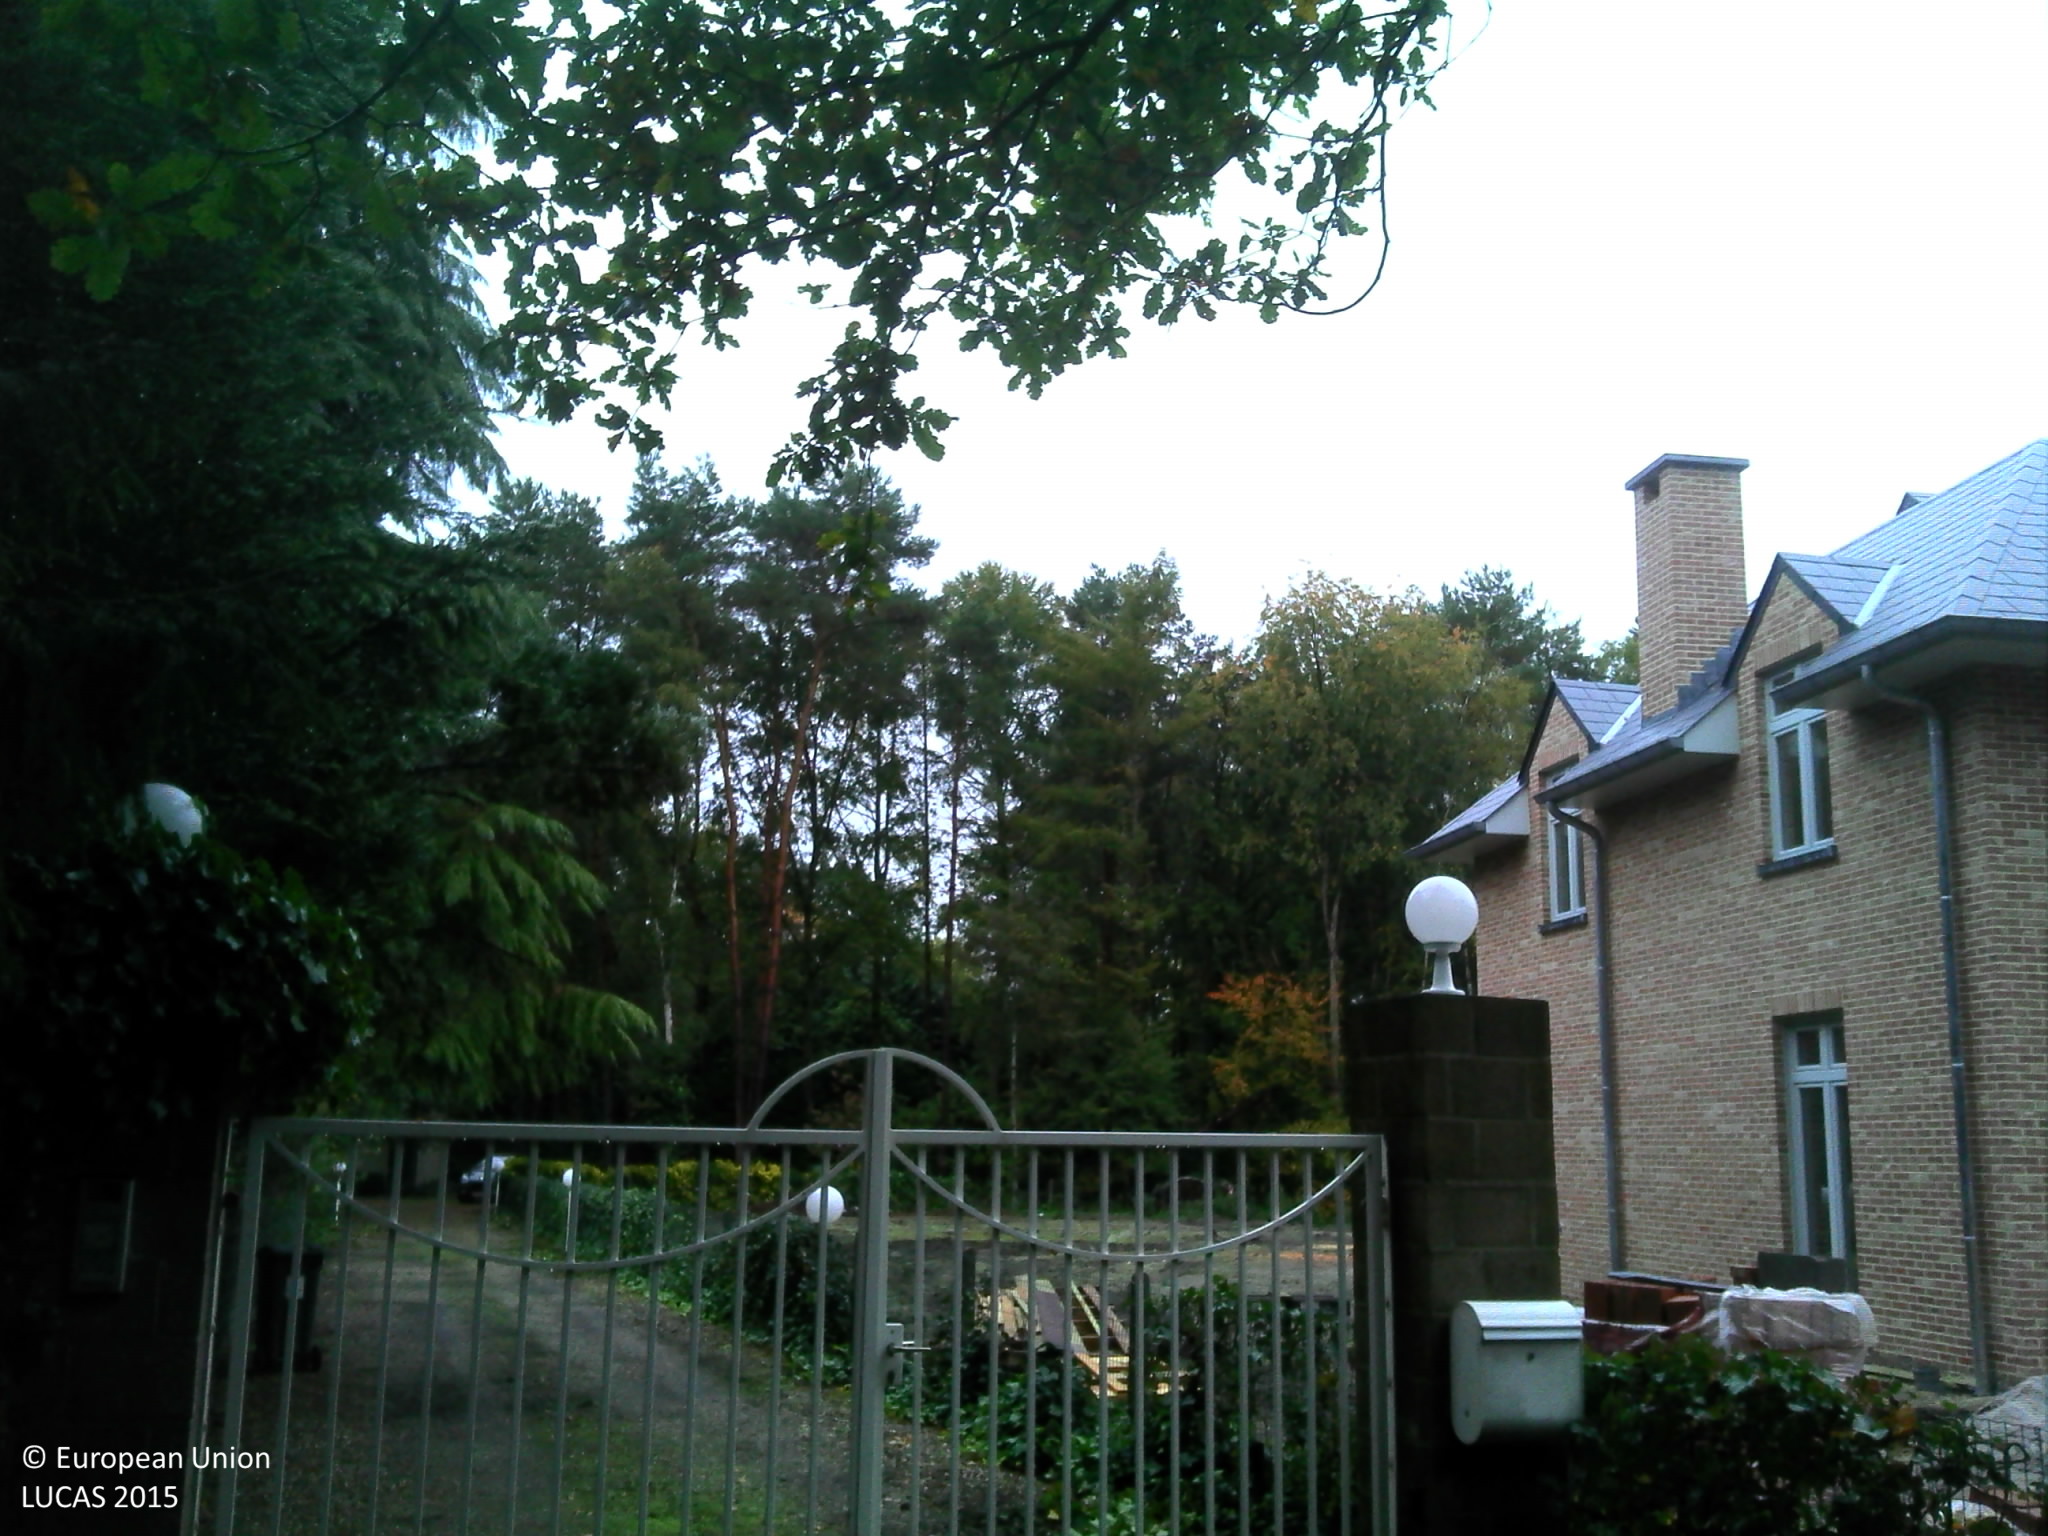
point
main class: Woodland
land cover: Other mixed woodland
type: exotic forest
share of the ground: > 75 %
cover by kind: broadleaved forest trees 70 %, coniferous forest trees 30 %
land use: Residential
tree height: > 5 m
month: October
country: BE
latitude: 50.9972
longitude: 4.6815
